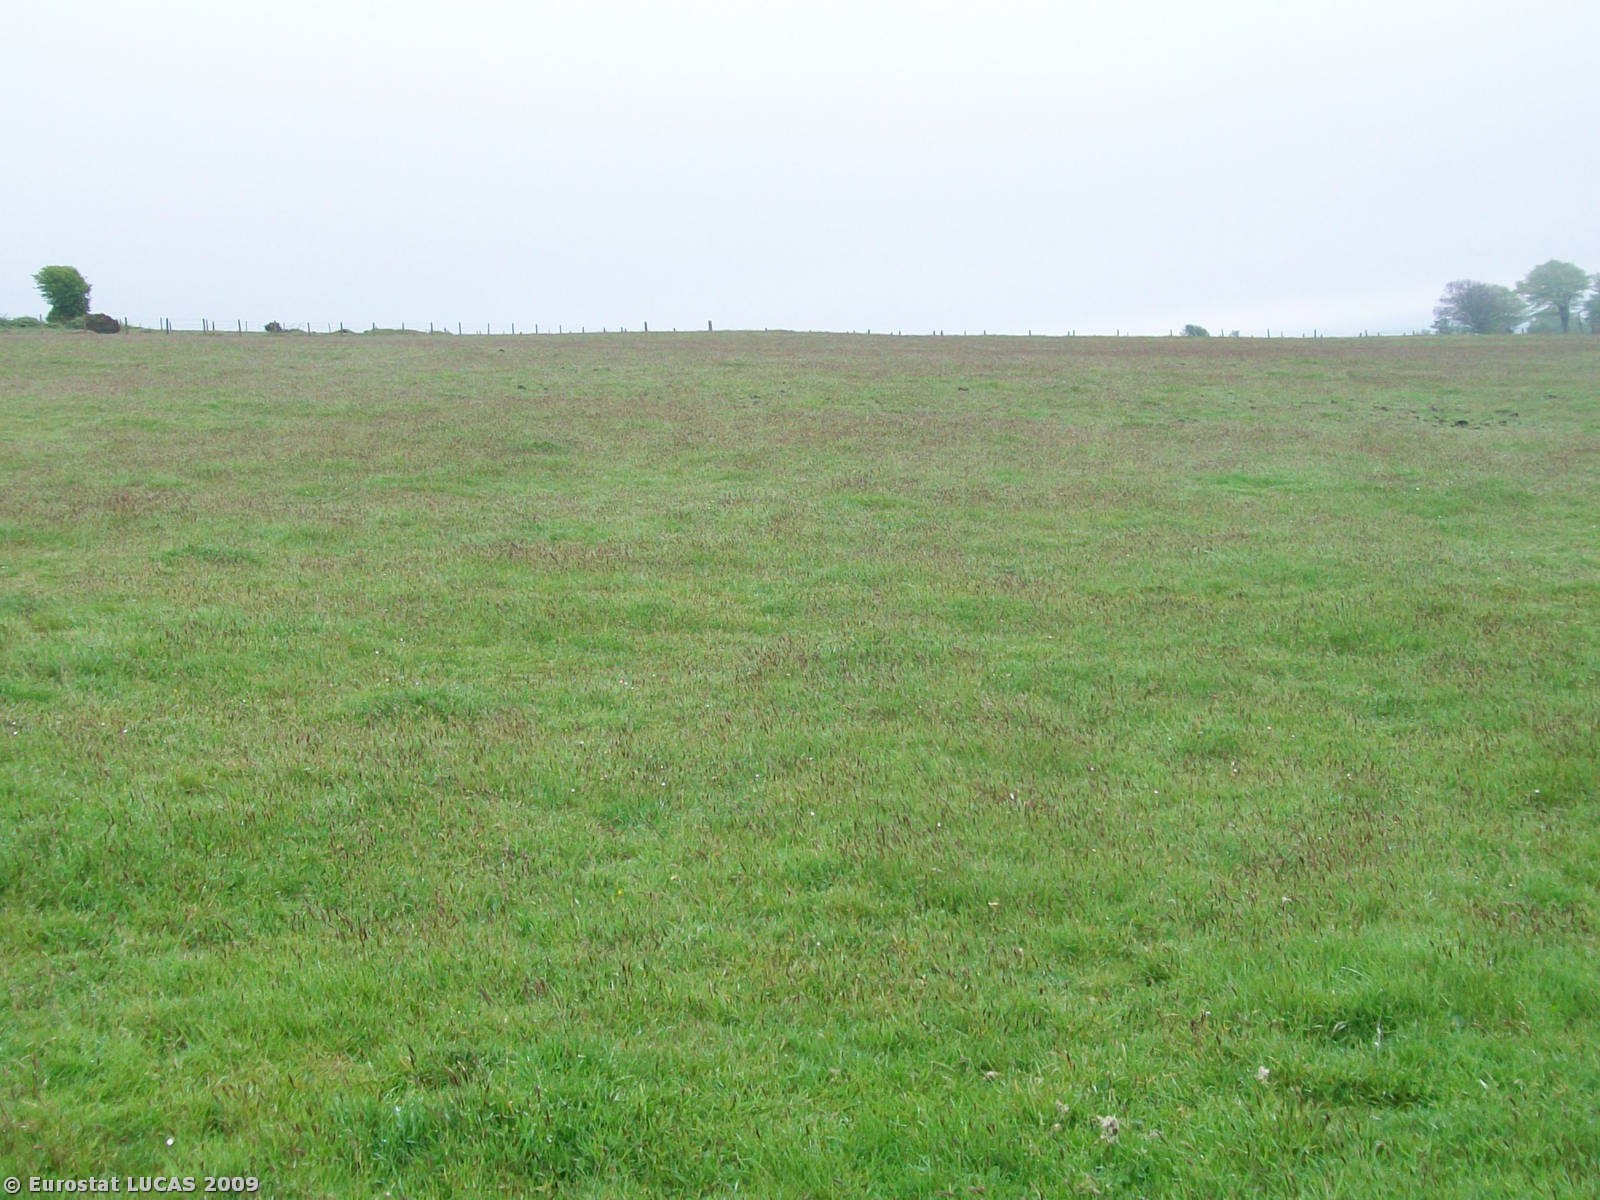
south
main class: Grassland
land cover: Grassland without tree/shrub cover
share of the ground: > 75 %
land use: Agriculture (excluding fallow land and kitchen gardens)
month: May
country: GB
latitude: 50.5187
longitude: -4.3027
